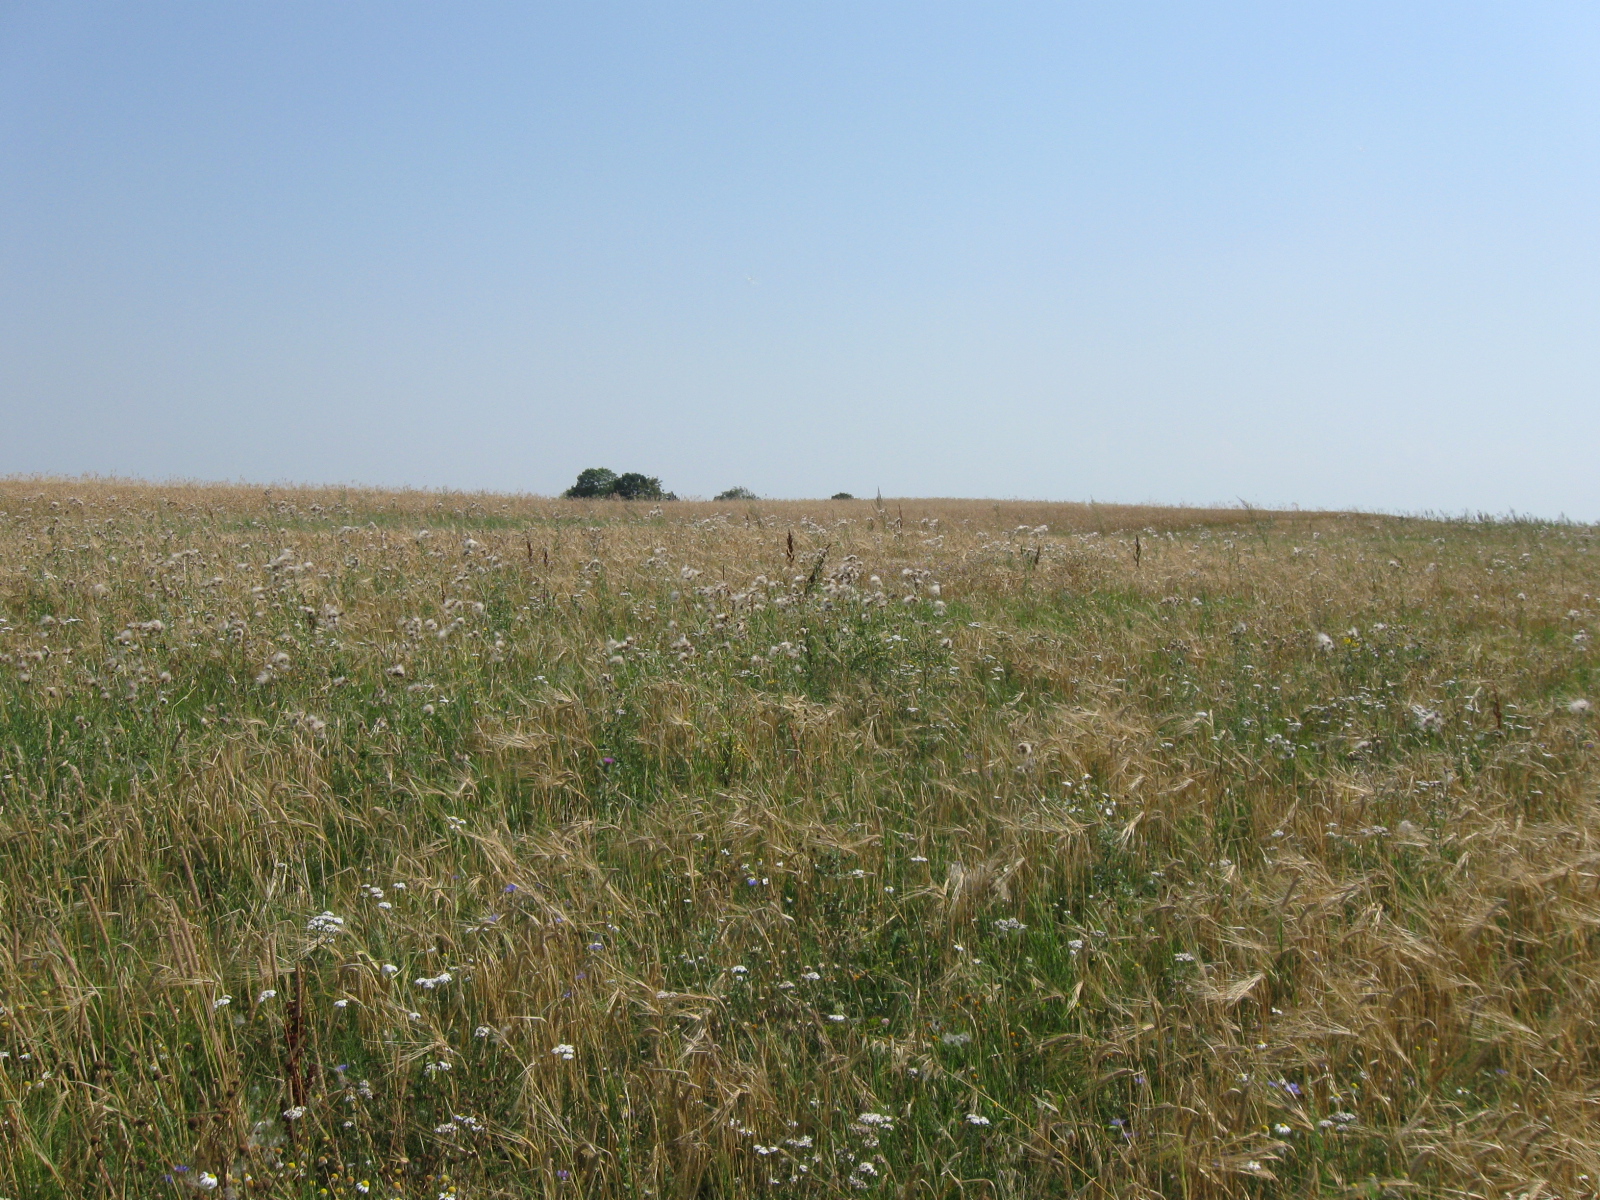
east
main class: Cropland
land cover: Barley
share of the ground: 50 - 75 %
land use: Agriculture (excluding fallow land and kitchen gardens)
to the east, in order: Barley; Common wheat; Grass margins; Barley; Grassland without tree/shrub cover; Tracks; Grass margins; Other bare soil; Grass margins; Tracks; Grass margins; Mixed cereals for fodder
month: August
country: LT
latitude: 54.3846
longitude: 23.2425
